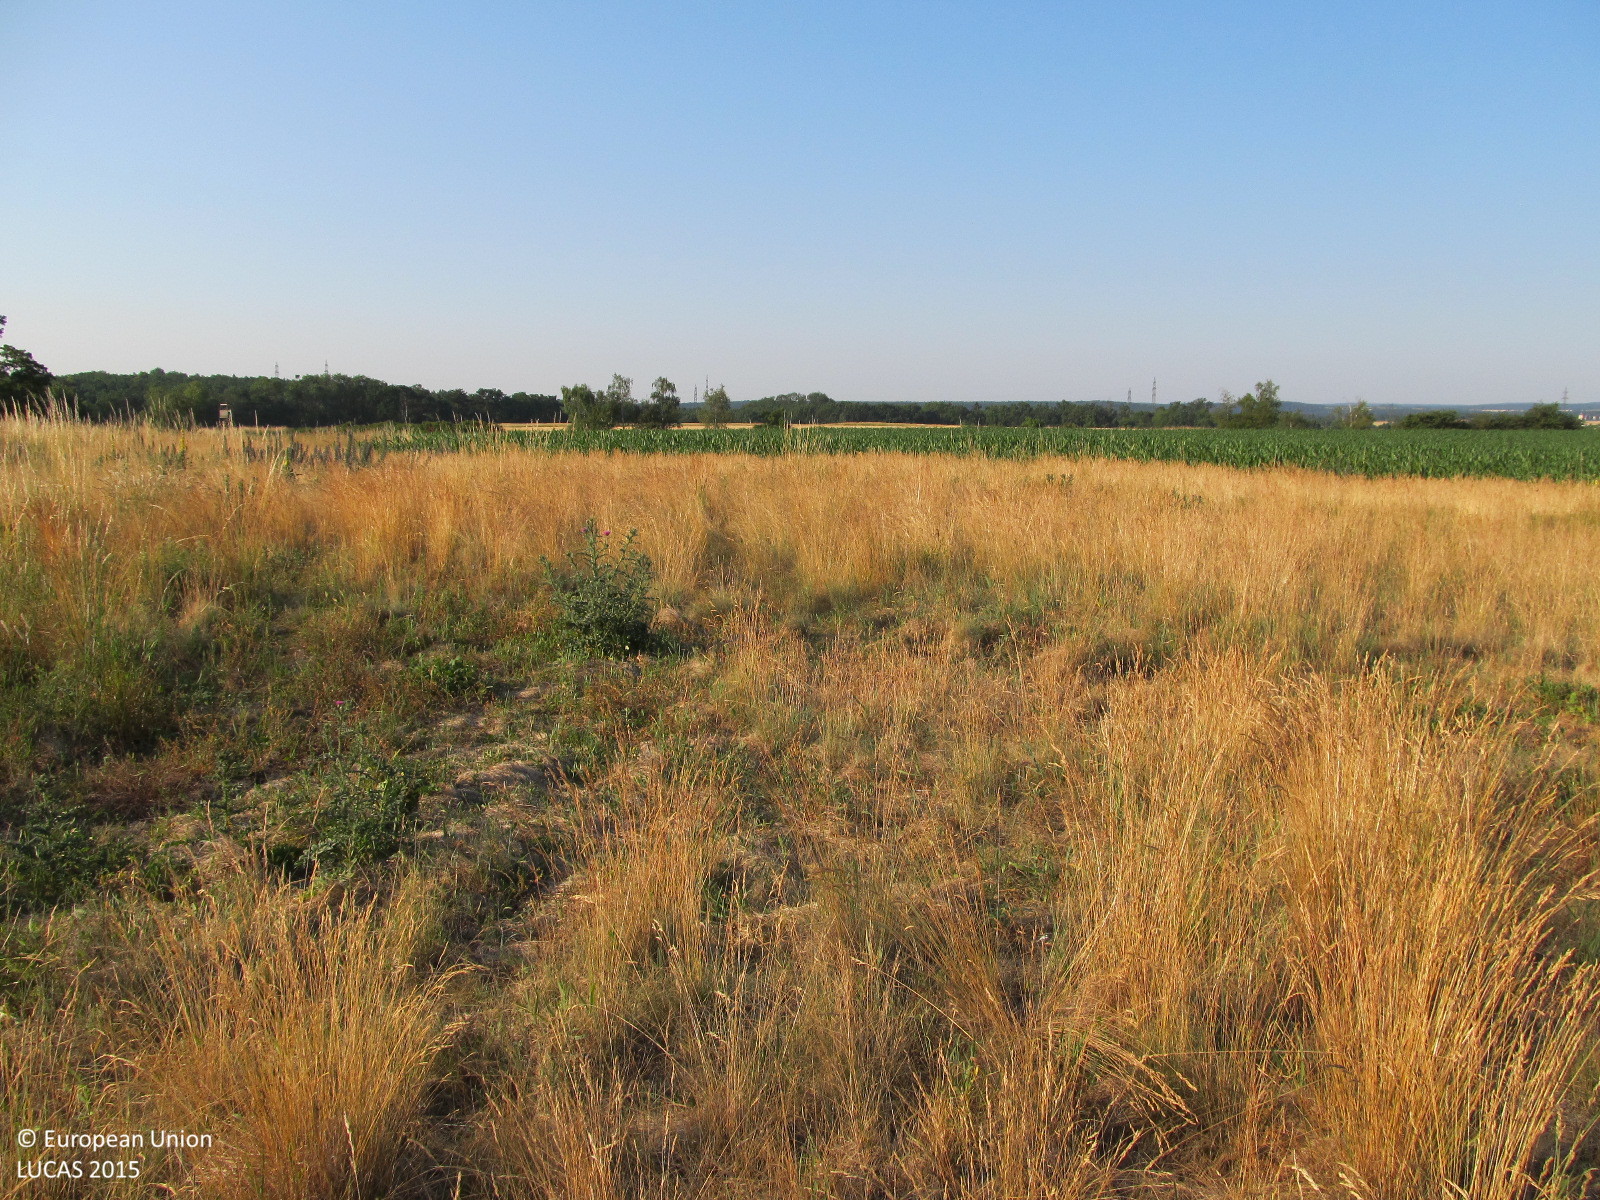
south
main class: Grassland
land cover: Grassland without tree/shrub cover
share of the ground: > 75 %
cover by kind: herbaceous plants 100 %
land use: Agriculture (excluding fallow land and kitchen gardens)
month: July
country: AT
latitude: 48.6551
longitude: 15.6643
